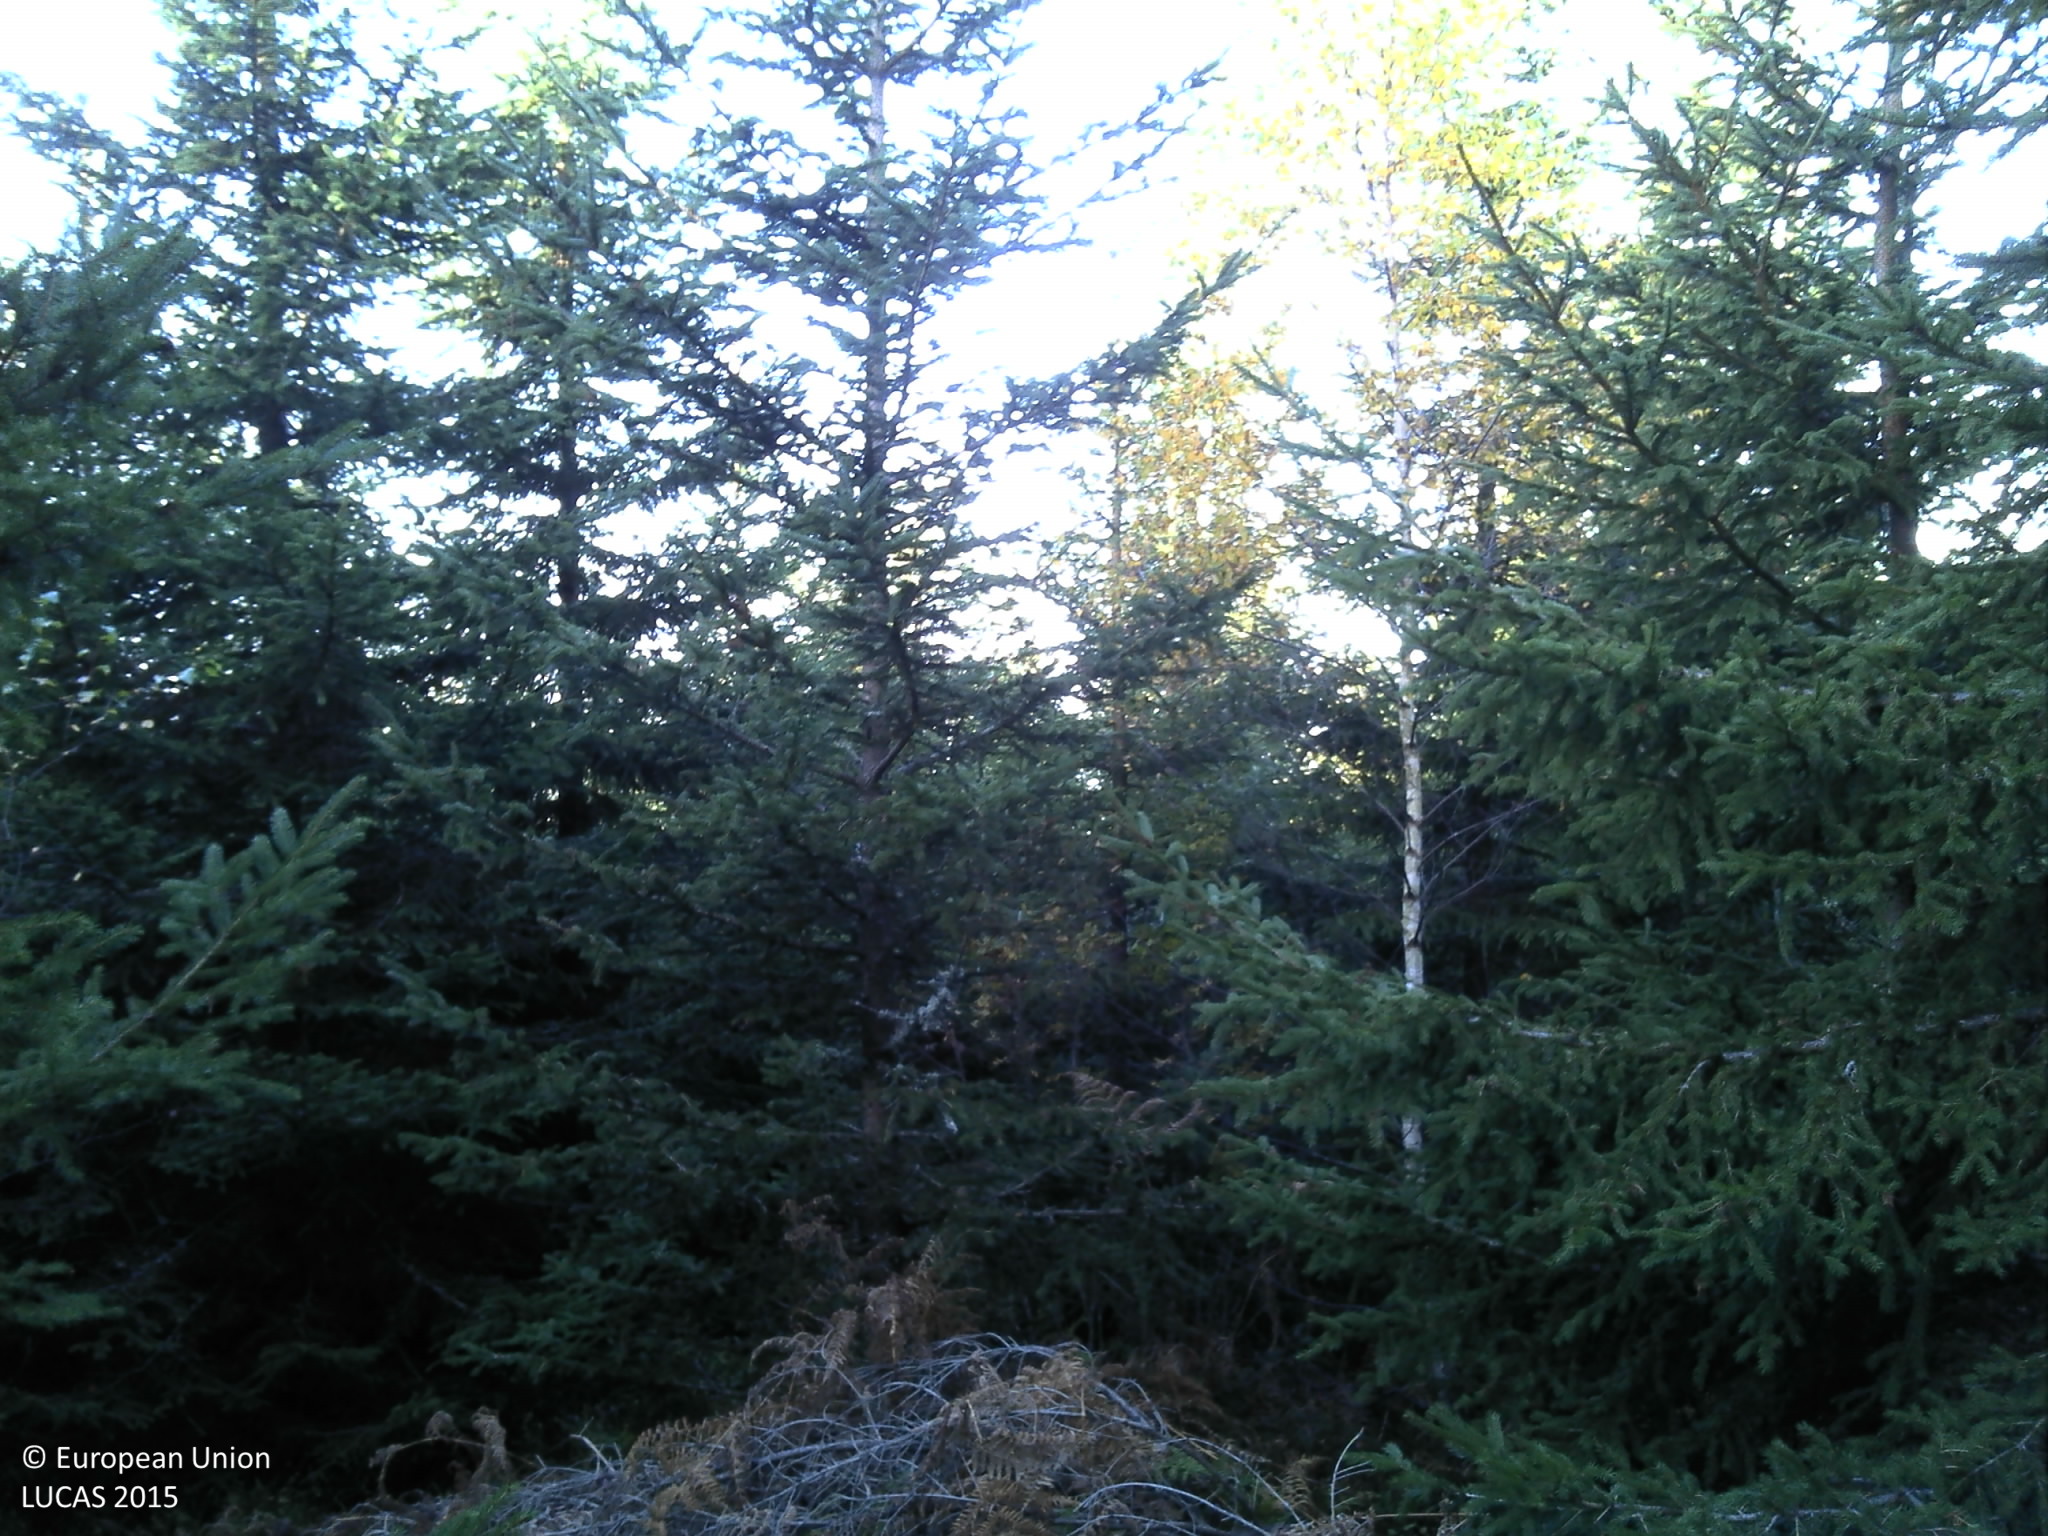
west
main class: Woodland
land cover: Spruce dominated coniferous woodland
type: exotic forest
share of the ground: > 75 %
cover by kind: coniferous forest trees 90 %, shrubs 5 %, herbaceous plants 5 %
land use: Forestry
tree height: > 5 m
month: October
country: FR
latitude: 45.6985
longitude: 3.7474
